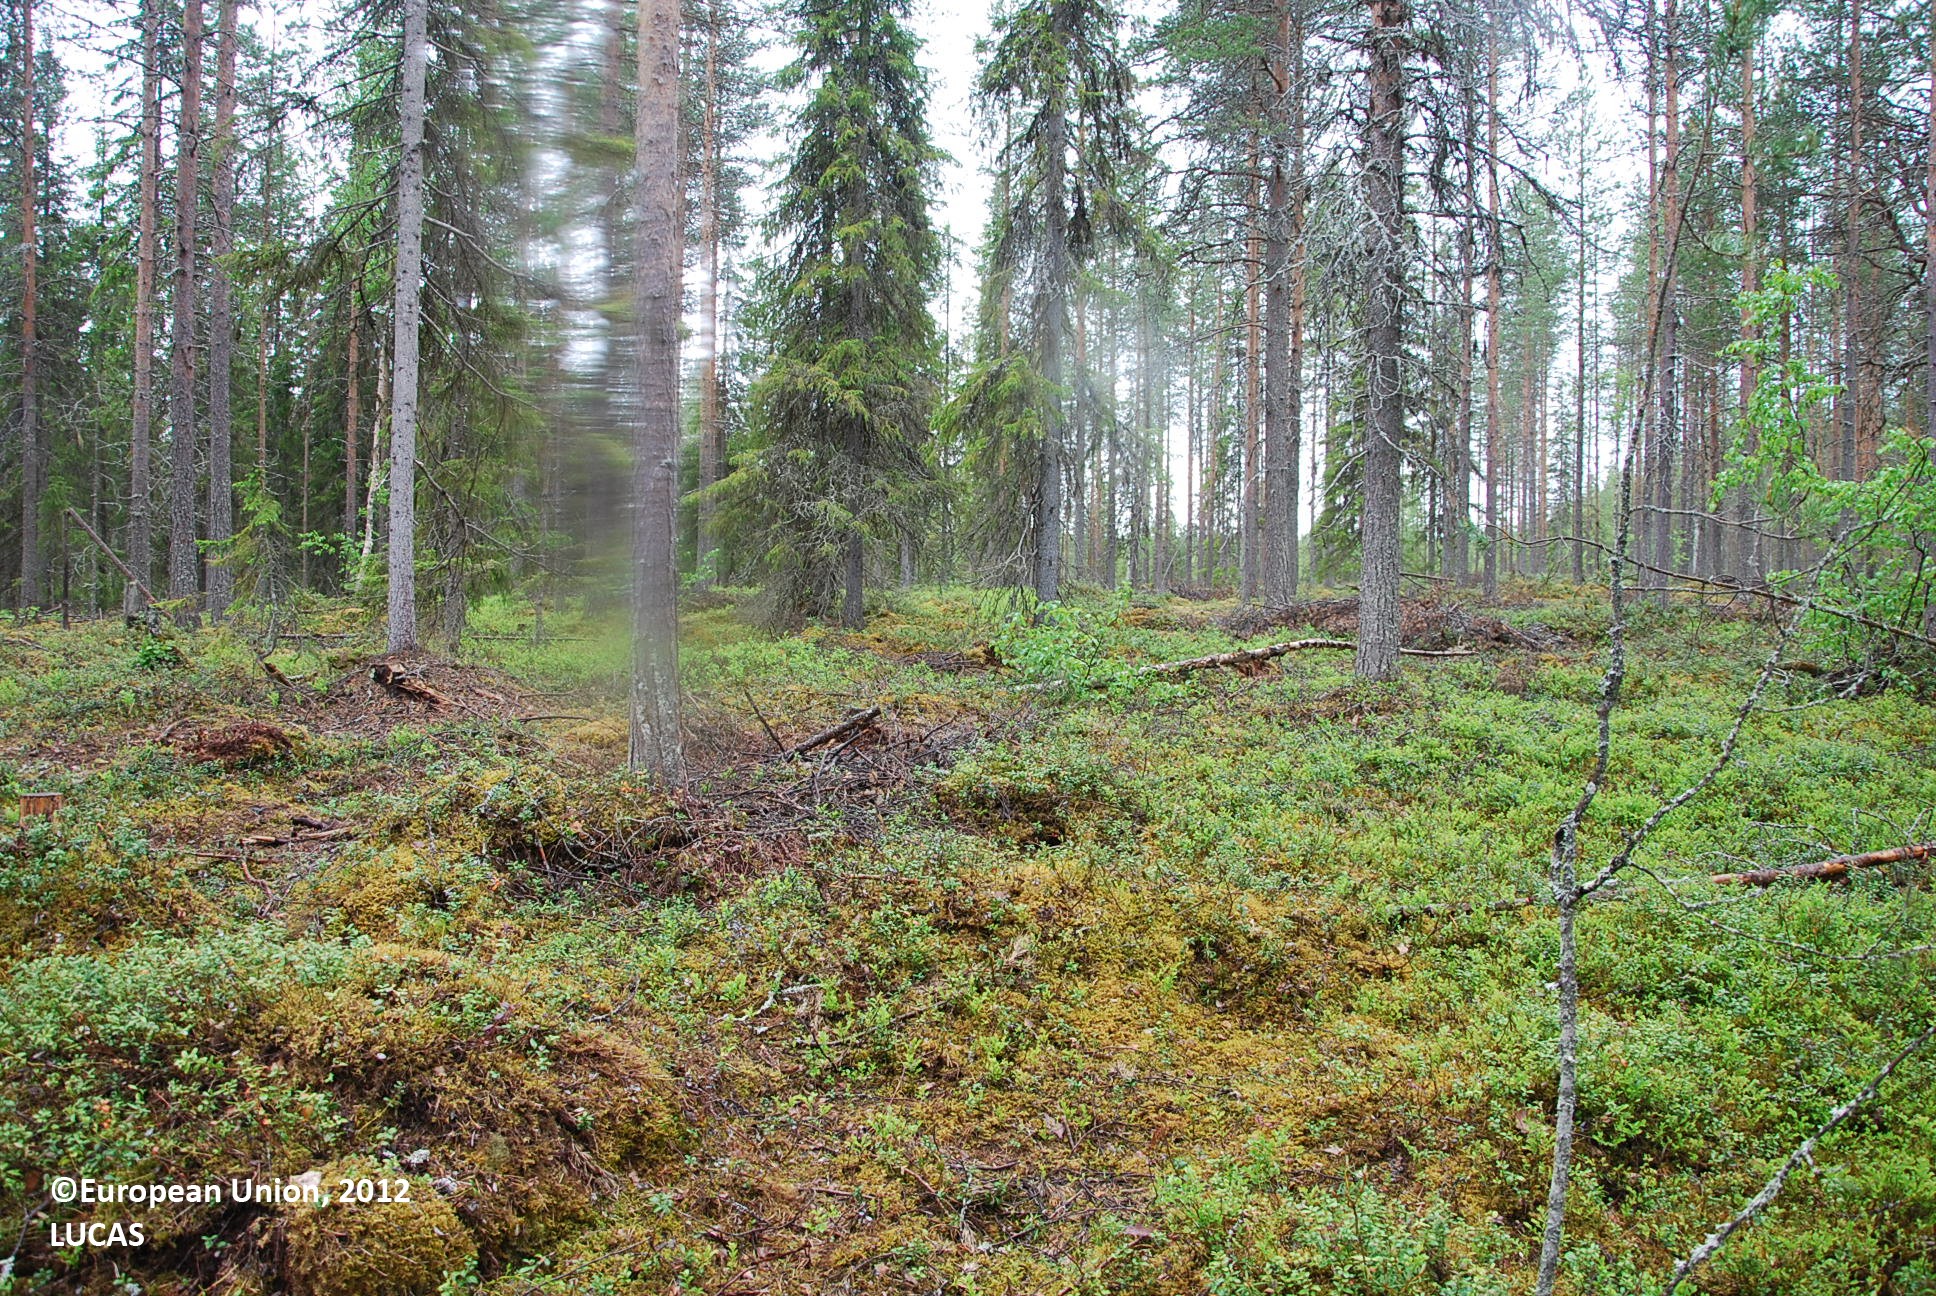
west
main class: Woodland
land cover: Other coniferous woodland
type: boreal forest
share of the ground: > 75 %
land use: Forestry
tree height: > 5 m
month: June
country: FI
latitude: 66.2647
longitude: 26.9565
